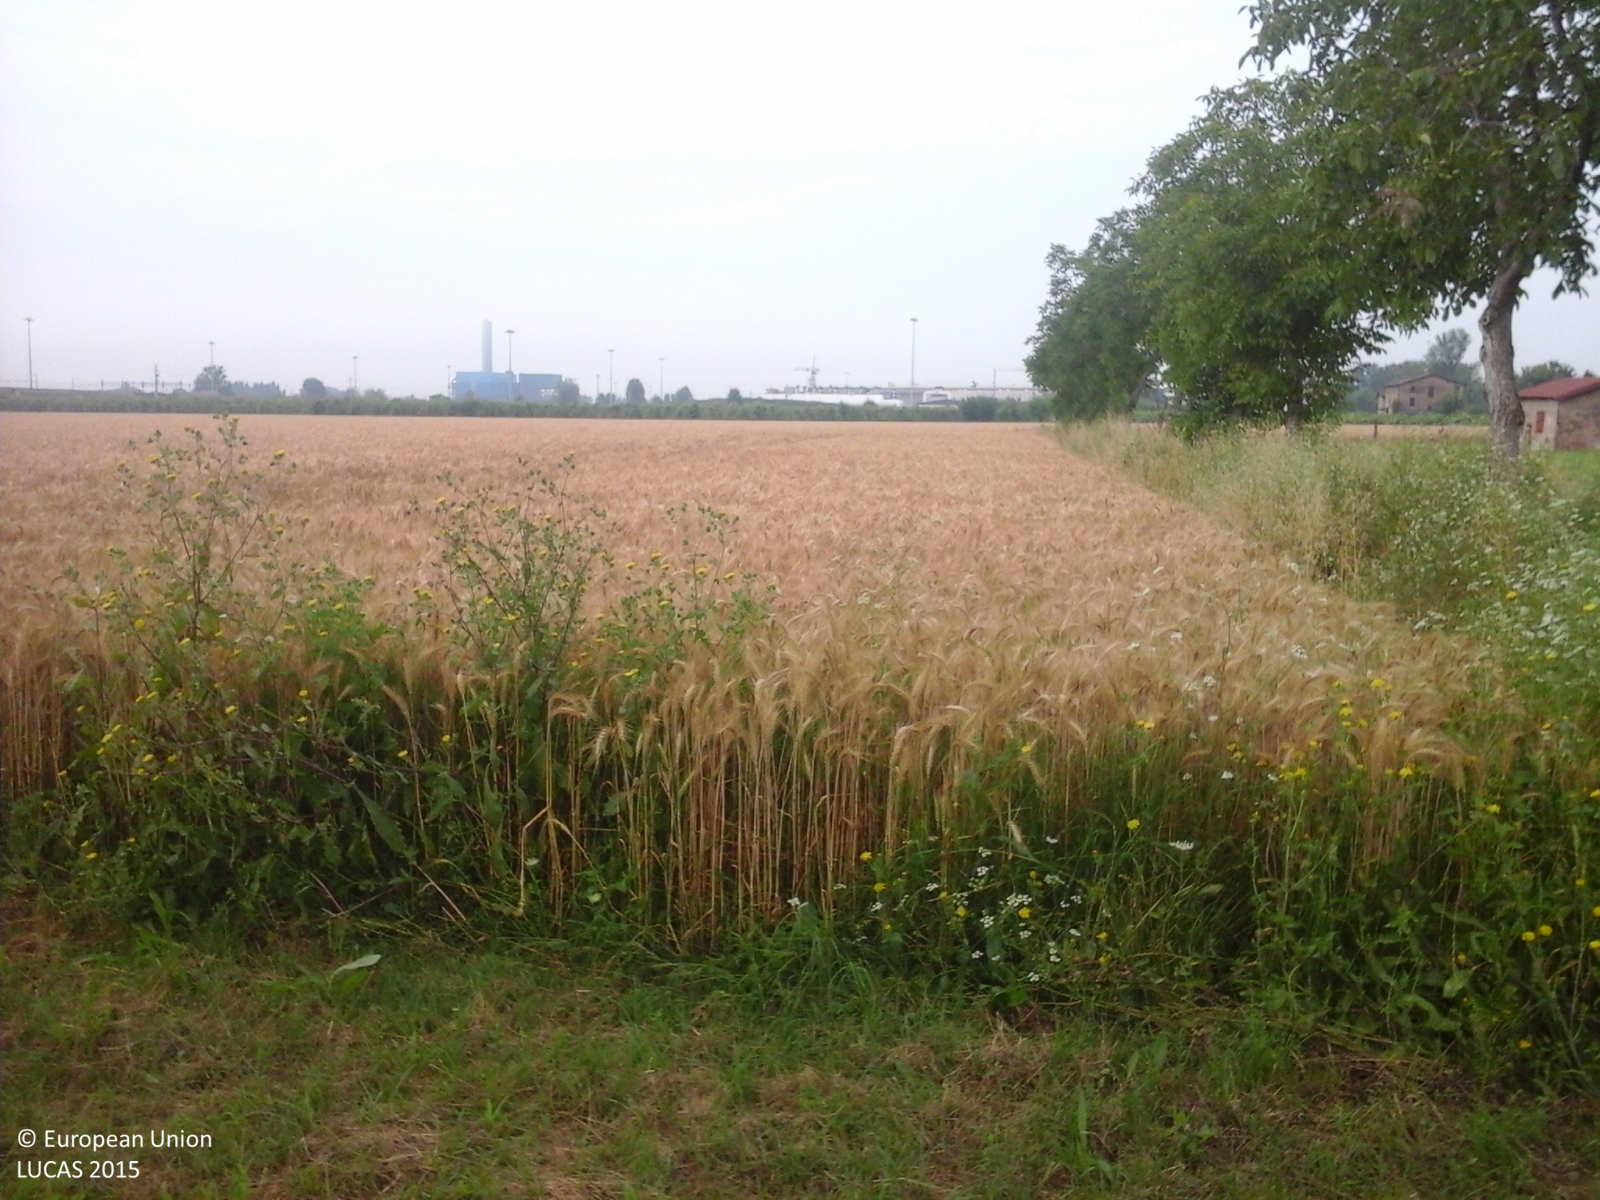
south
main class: Cropland
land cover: Common wheat
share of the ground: > 75 %
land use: Agriculture (excluding fallow land and kitchen gardens)
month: June
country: IT
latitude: 44.6889
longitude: 10.9443
